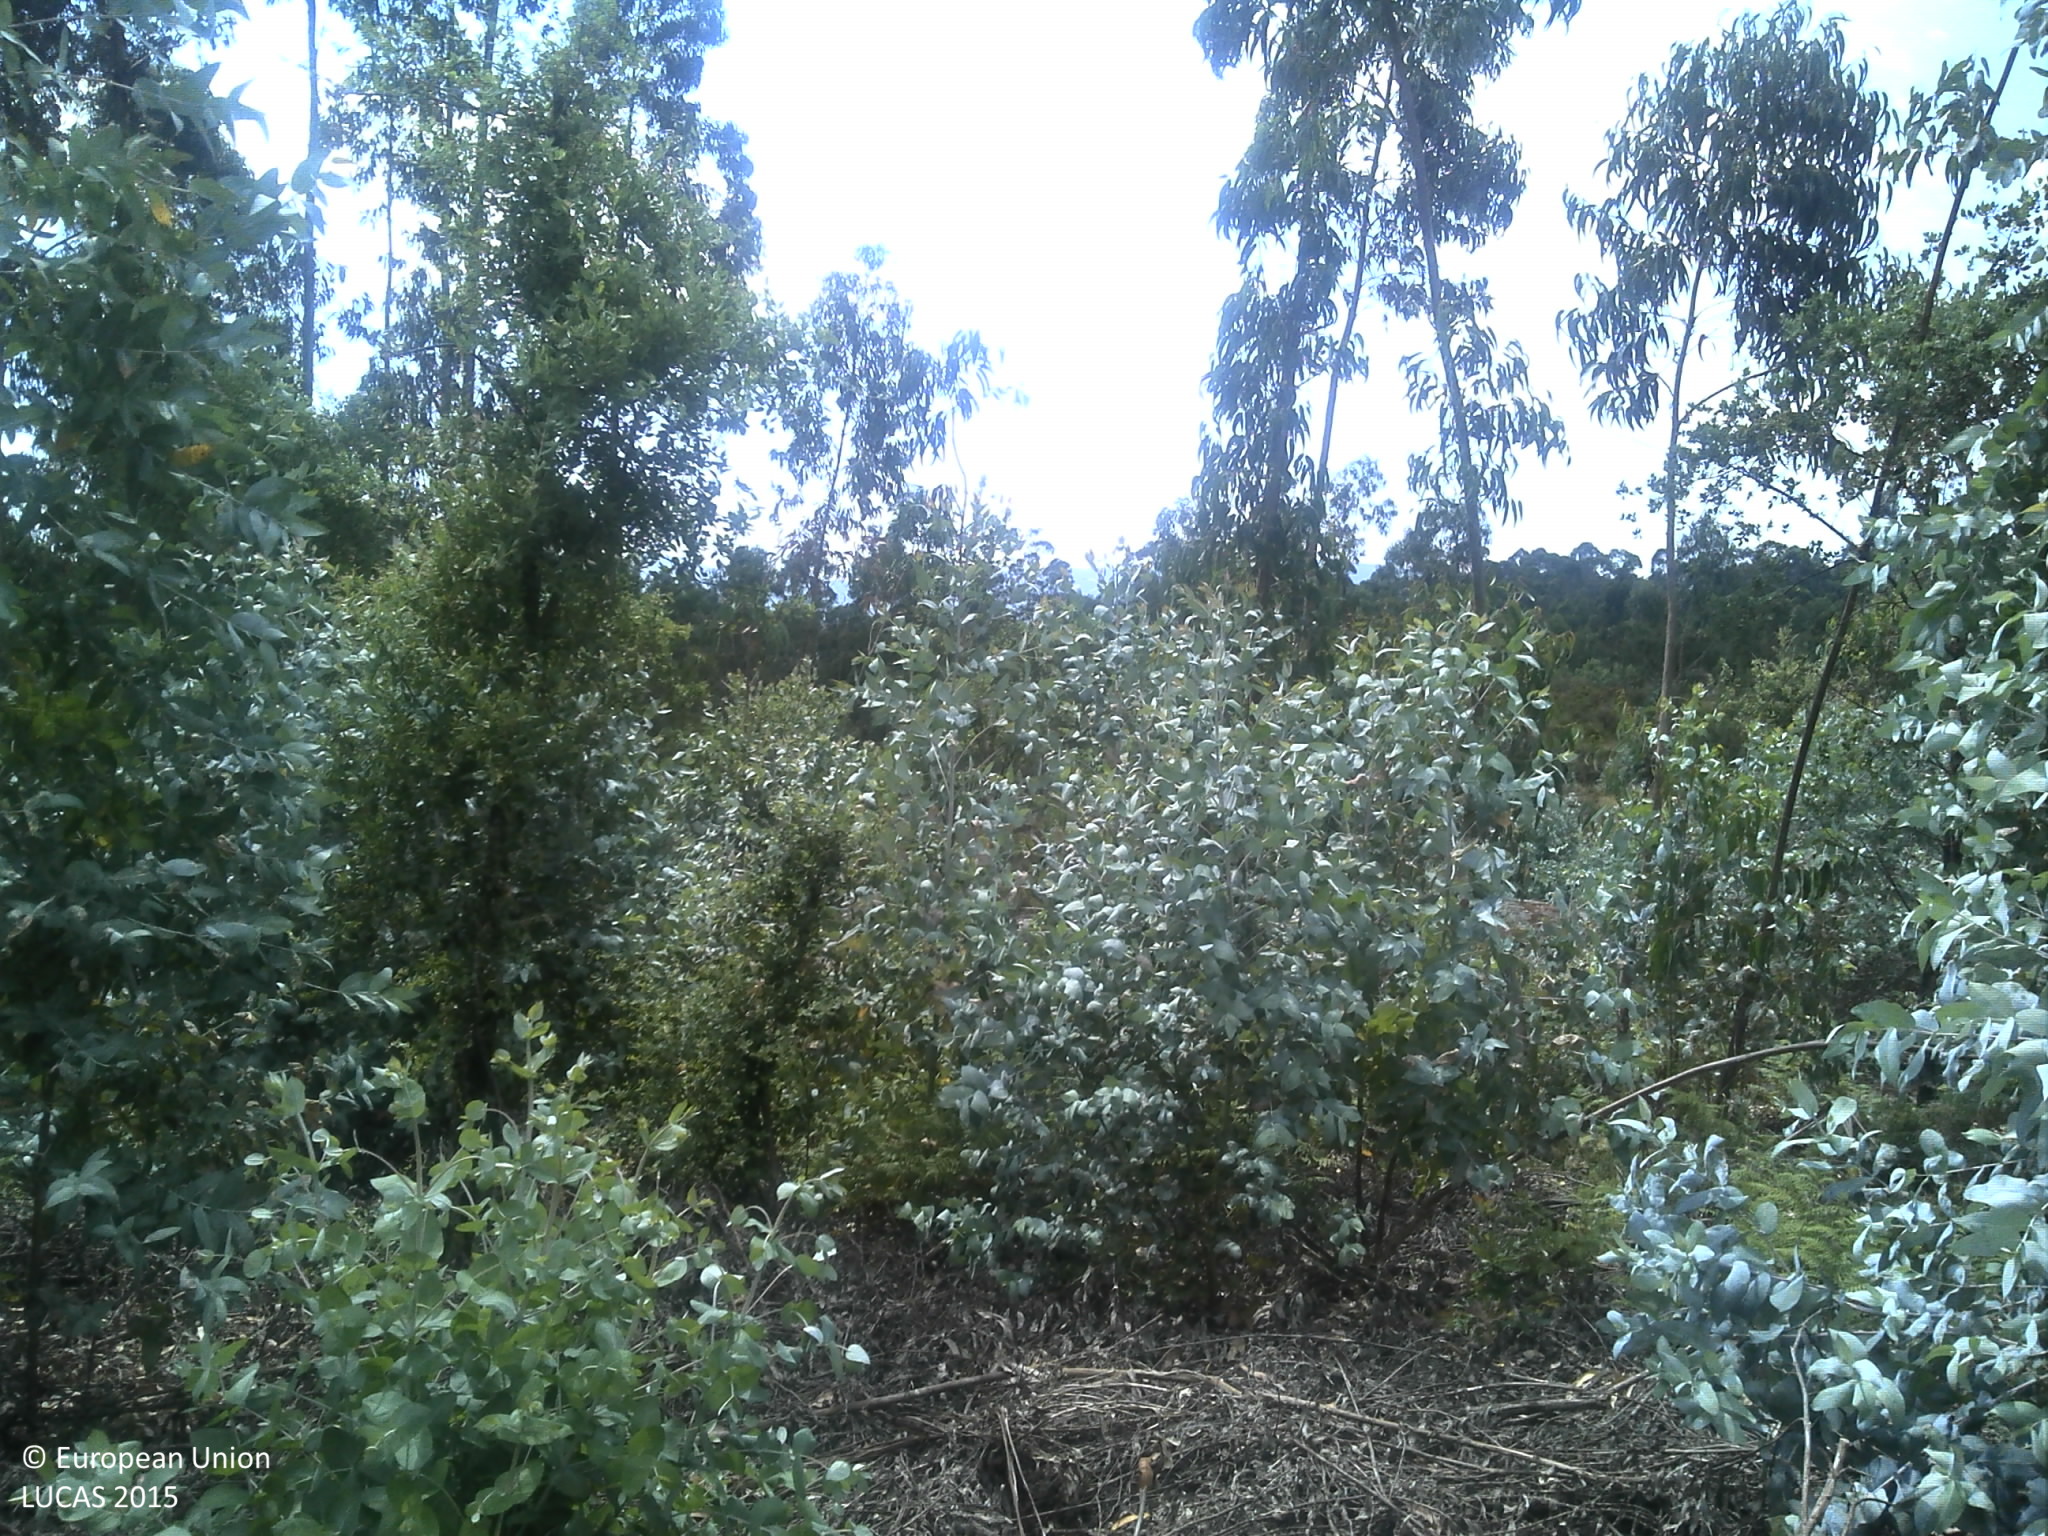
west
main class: Woodland
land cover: Broadleaved woodland
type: exotic forest
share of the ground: 25 - 50 %
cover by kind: broadleaved forest trees 50 %, unconsolidated bare surface 40 %, shrubs 10 %
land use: Forestry
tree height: < 5 m
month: June
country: PT
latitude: 41.5666
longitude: -8.5657
